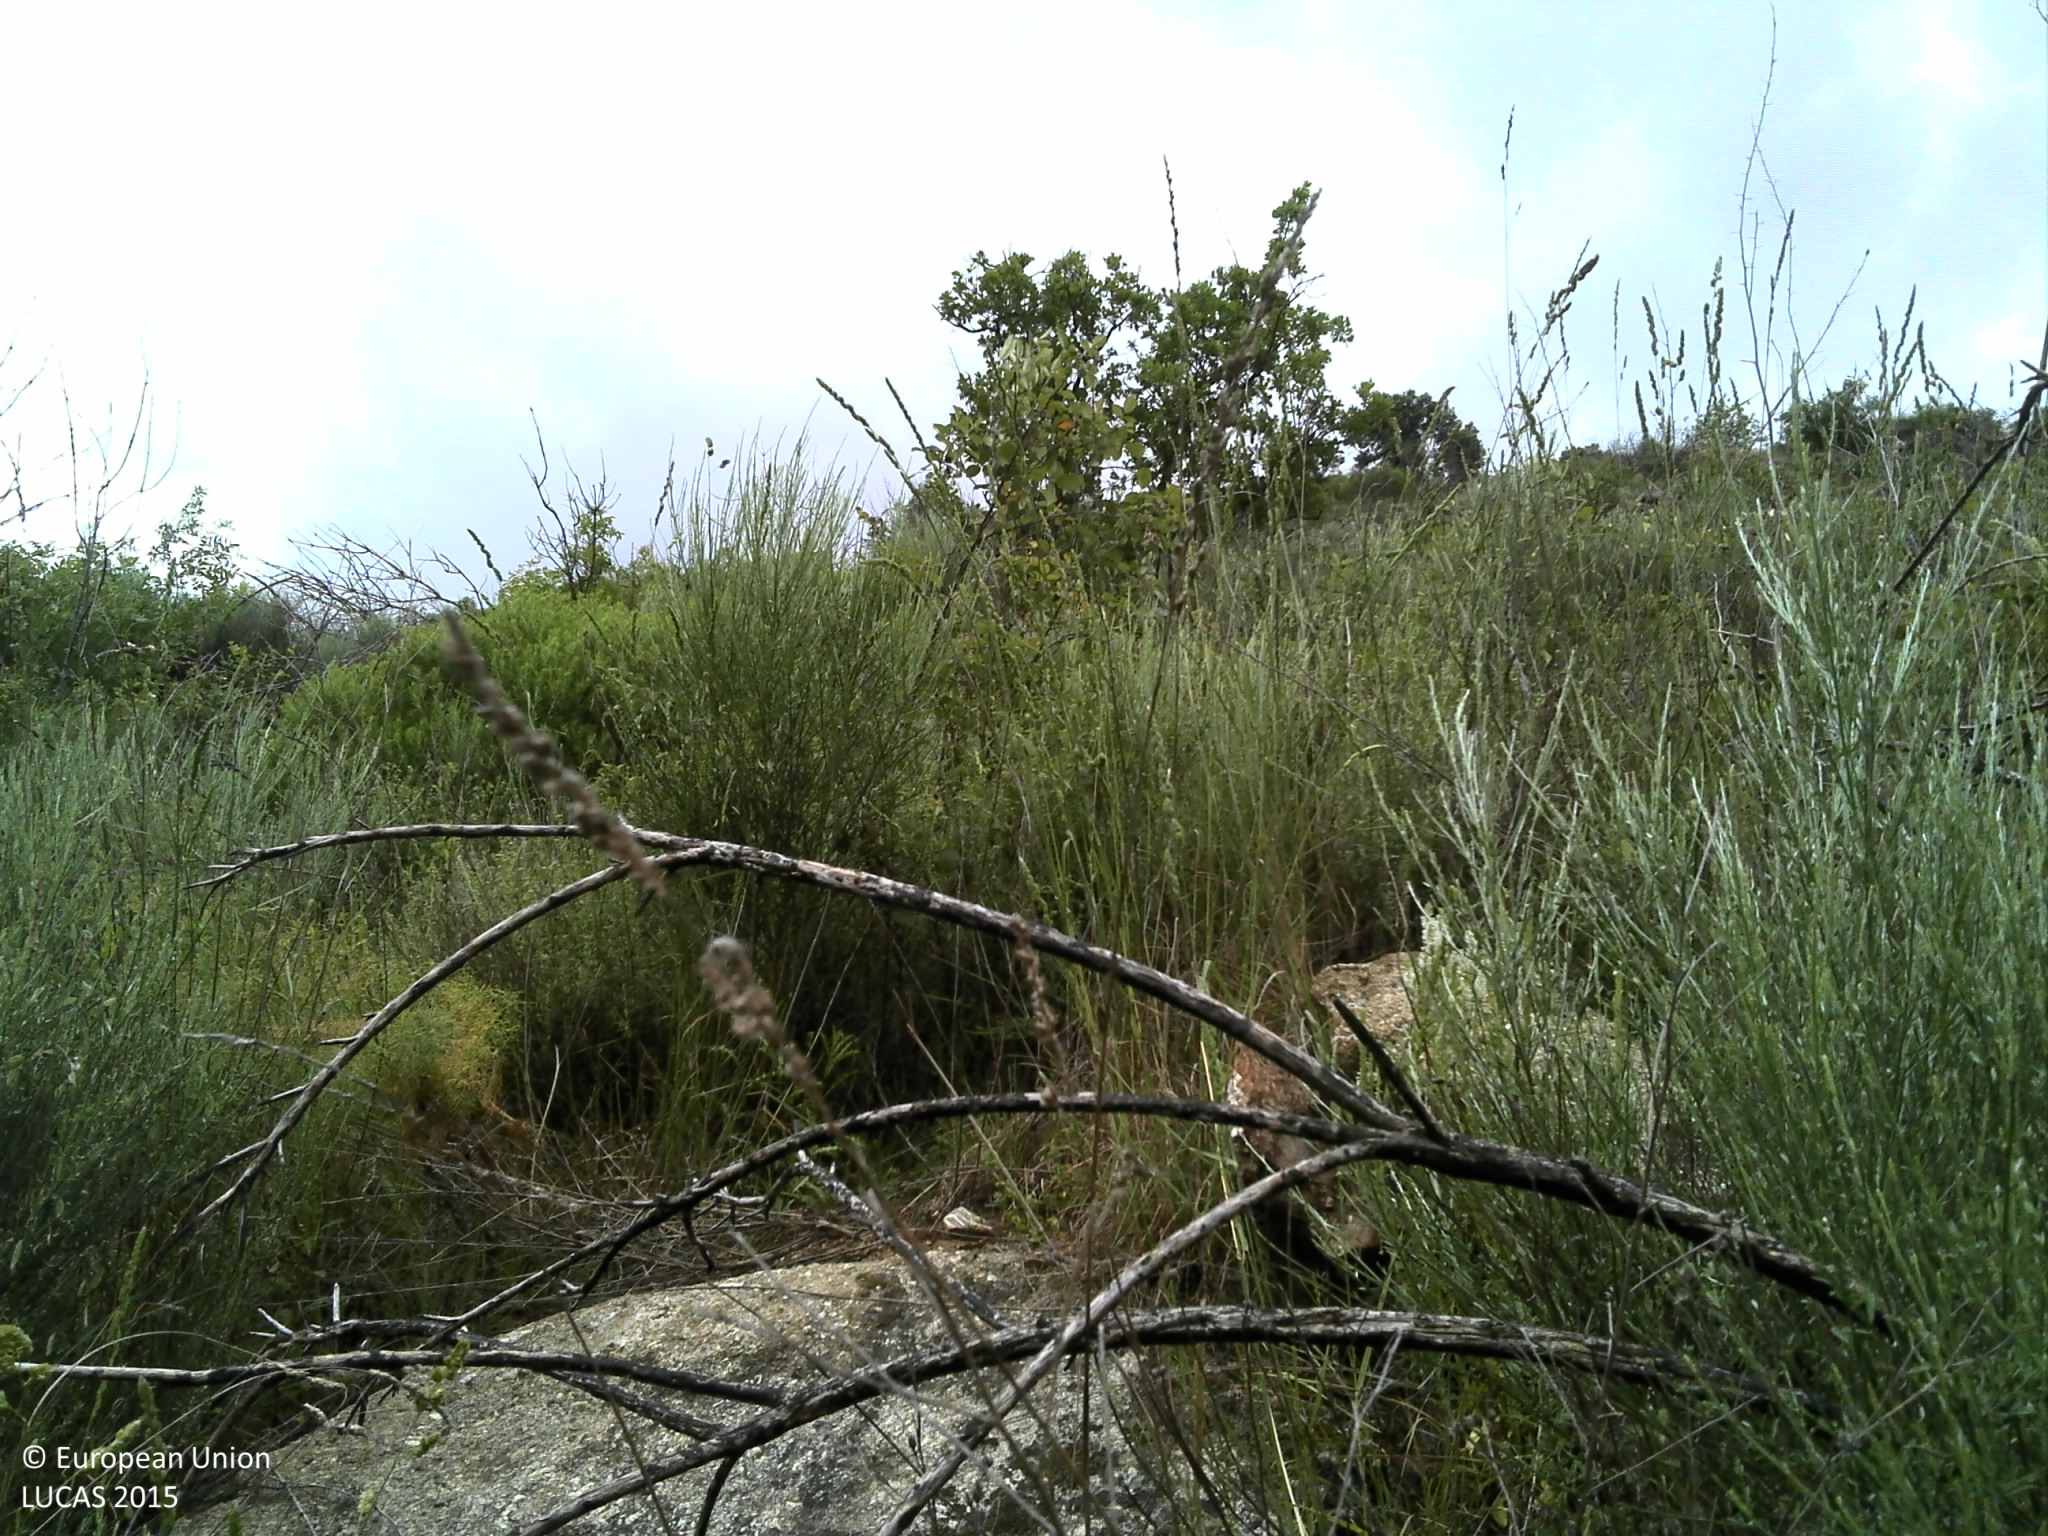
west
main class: Shrubland
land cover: Shrubland with sparse tree cover
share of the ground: > 75 %
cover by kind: shrubs 90 %, broadleaved forest trees 5 %, unconsolidated bare surface 5 %
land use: Forestry
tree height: < 5 m
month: May
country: PT
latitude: 41.6799
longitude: -7.0197
